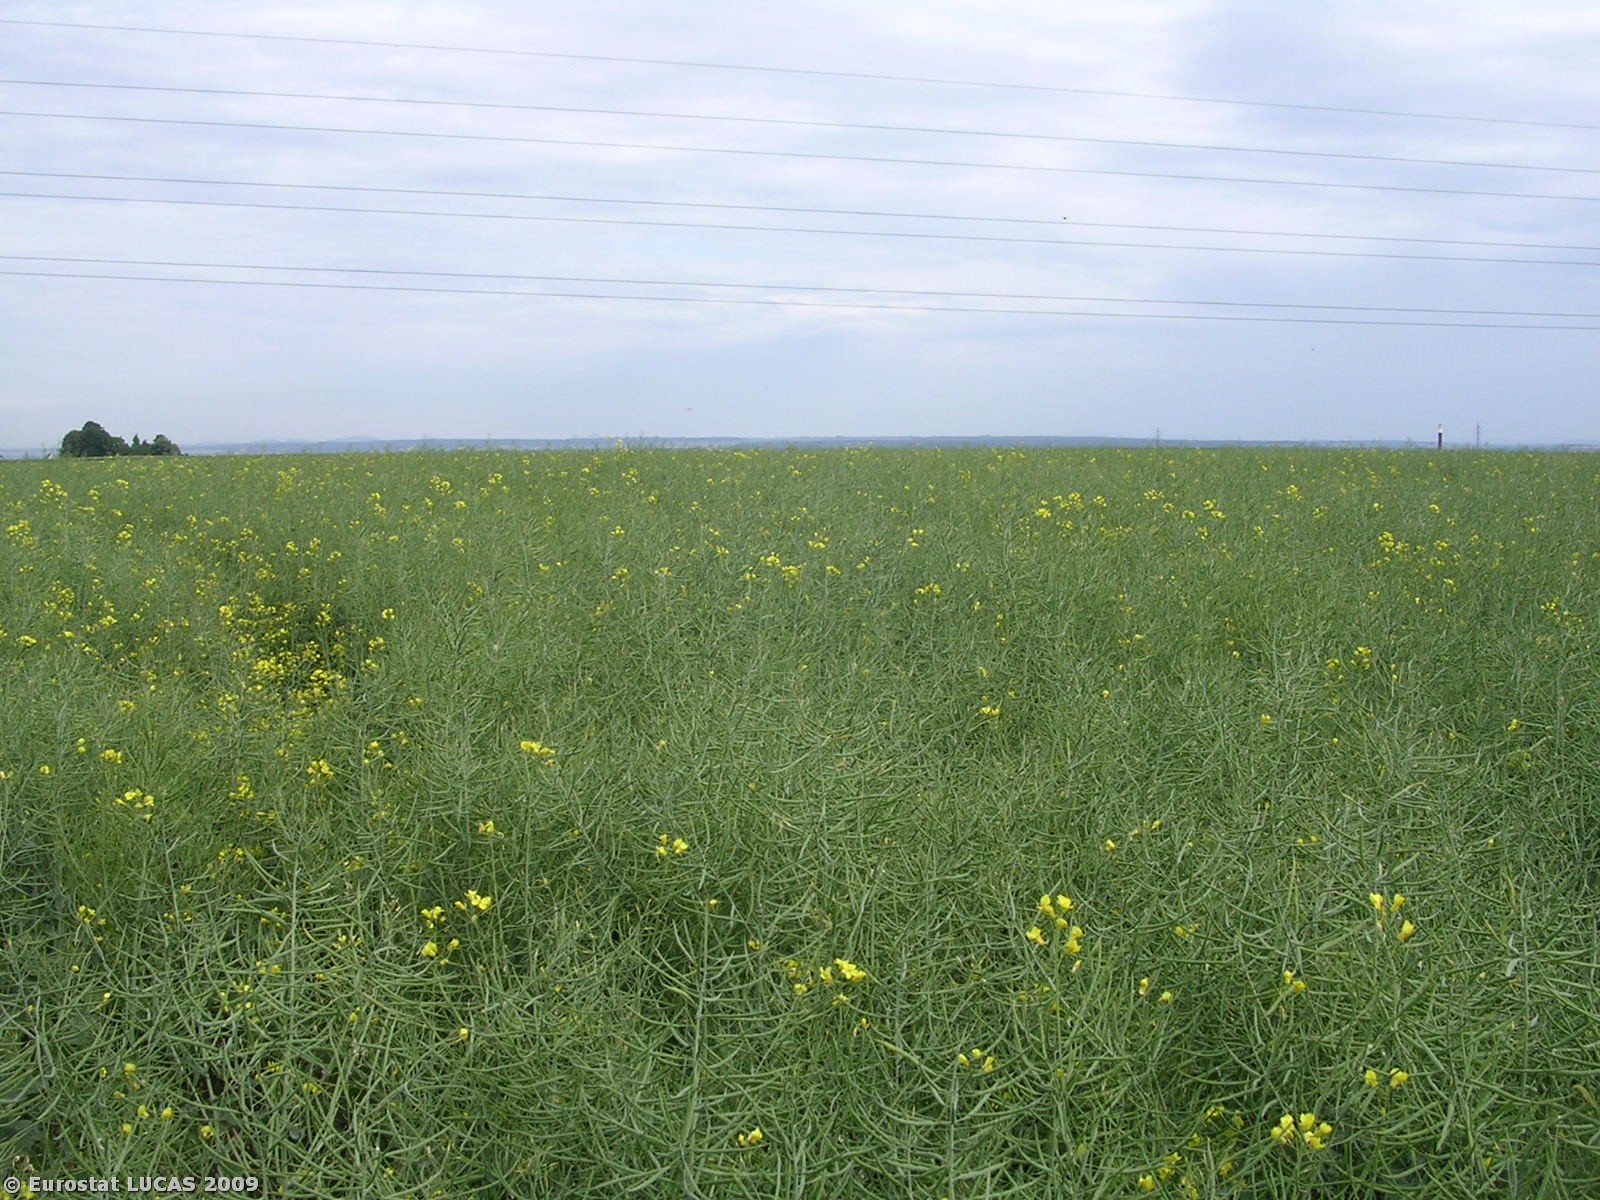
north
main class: Cropland
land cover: Rape and turnip rape
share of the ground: > 75 %
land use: Agriculture (excluding fallow land and kitchen gardens)
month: May
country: CZ
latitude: 50.1598
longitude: 14.6913
